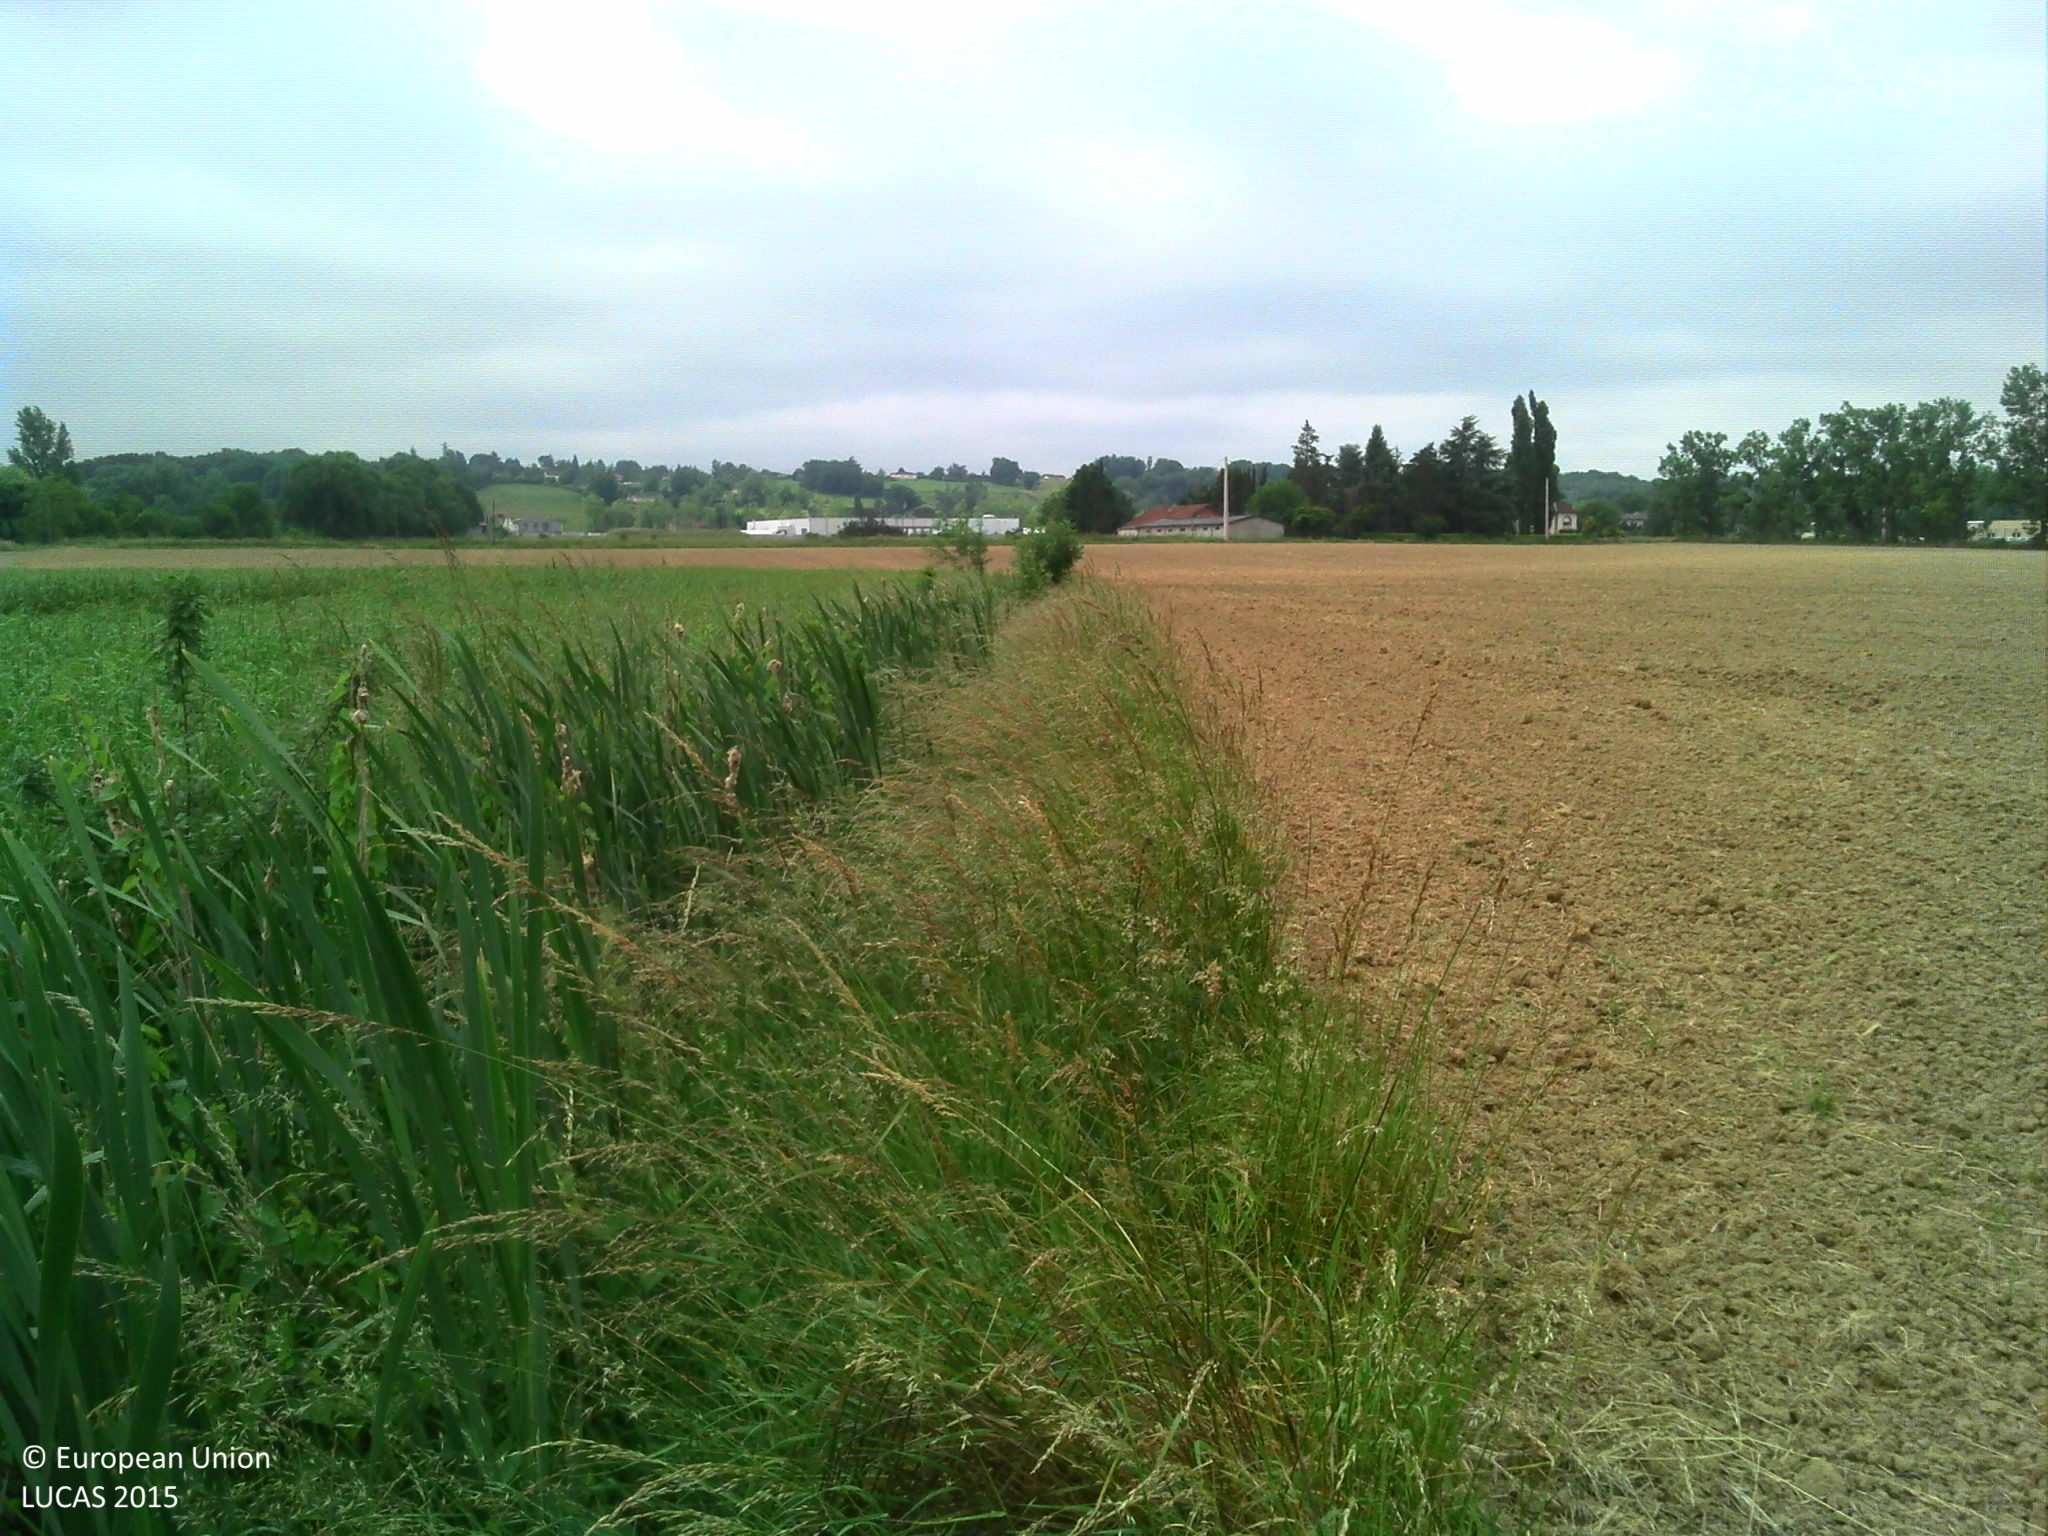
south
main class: Cropland
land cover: Common wheat
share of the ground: > 75 %
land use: Agriculture (excluding fallow land and kitchen gardens)
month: May
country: FR
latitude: 43.7670
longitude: 1.9667
